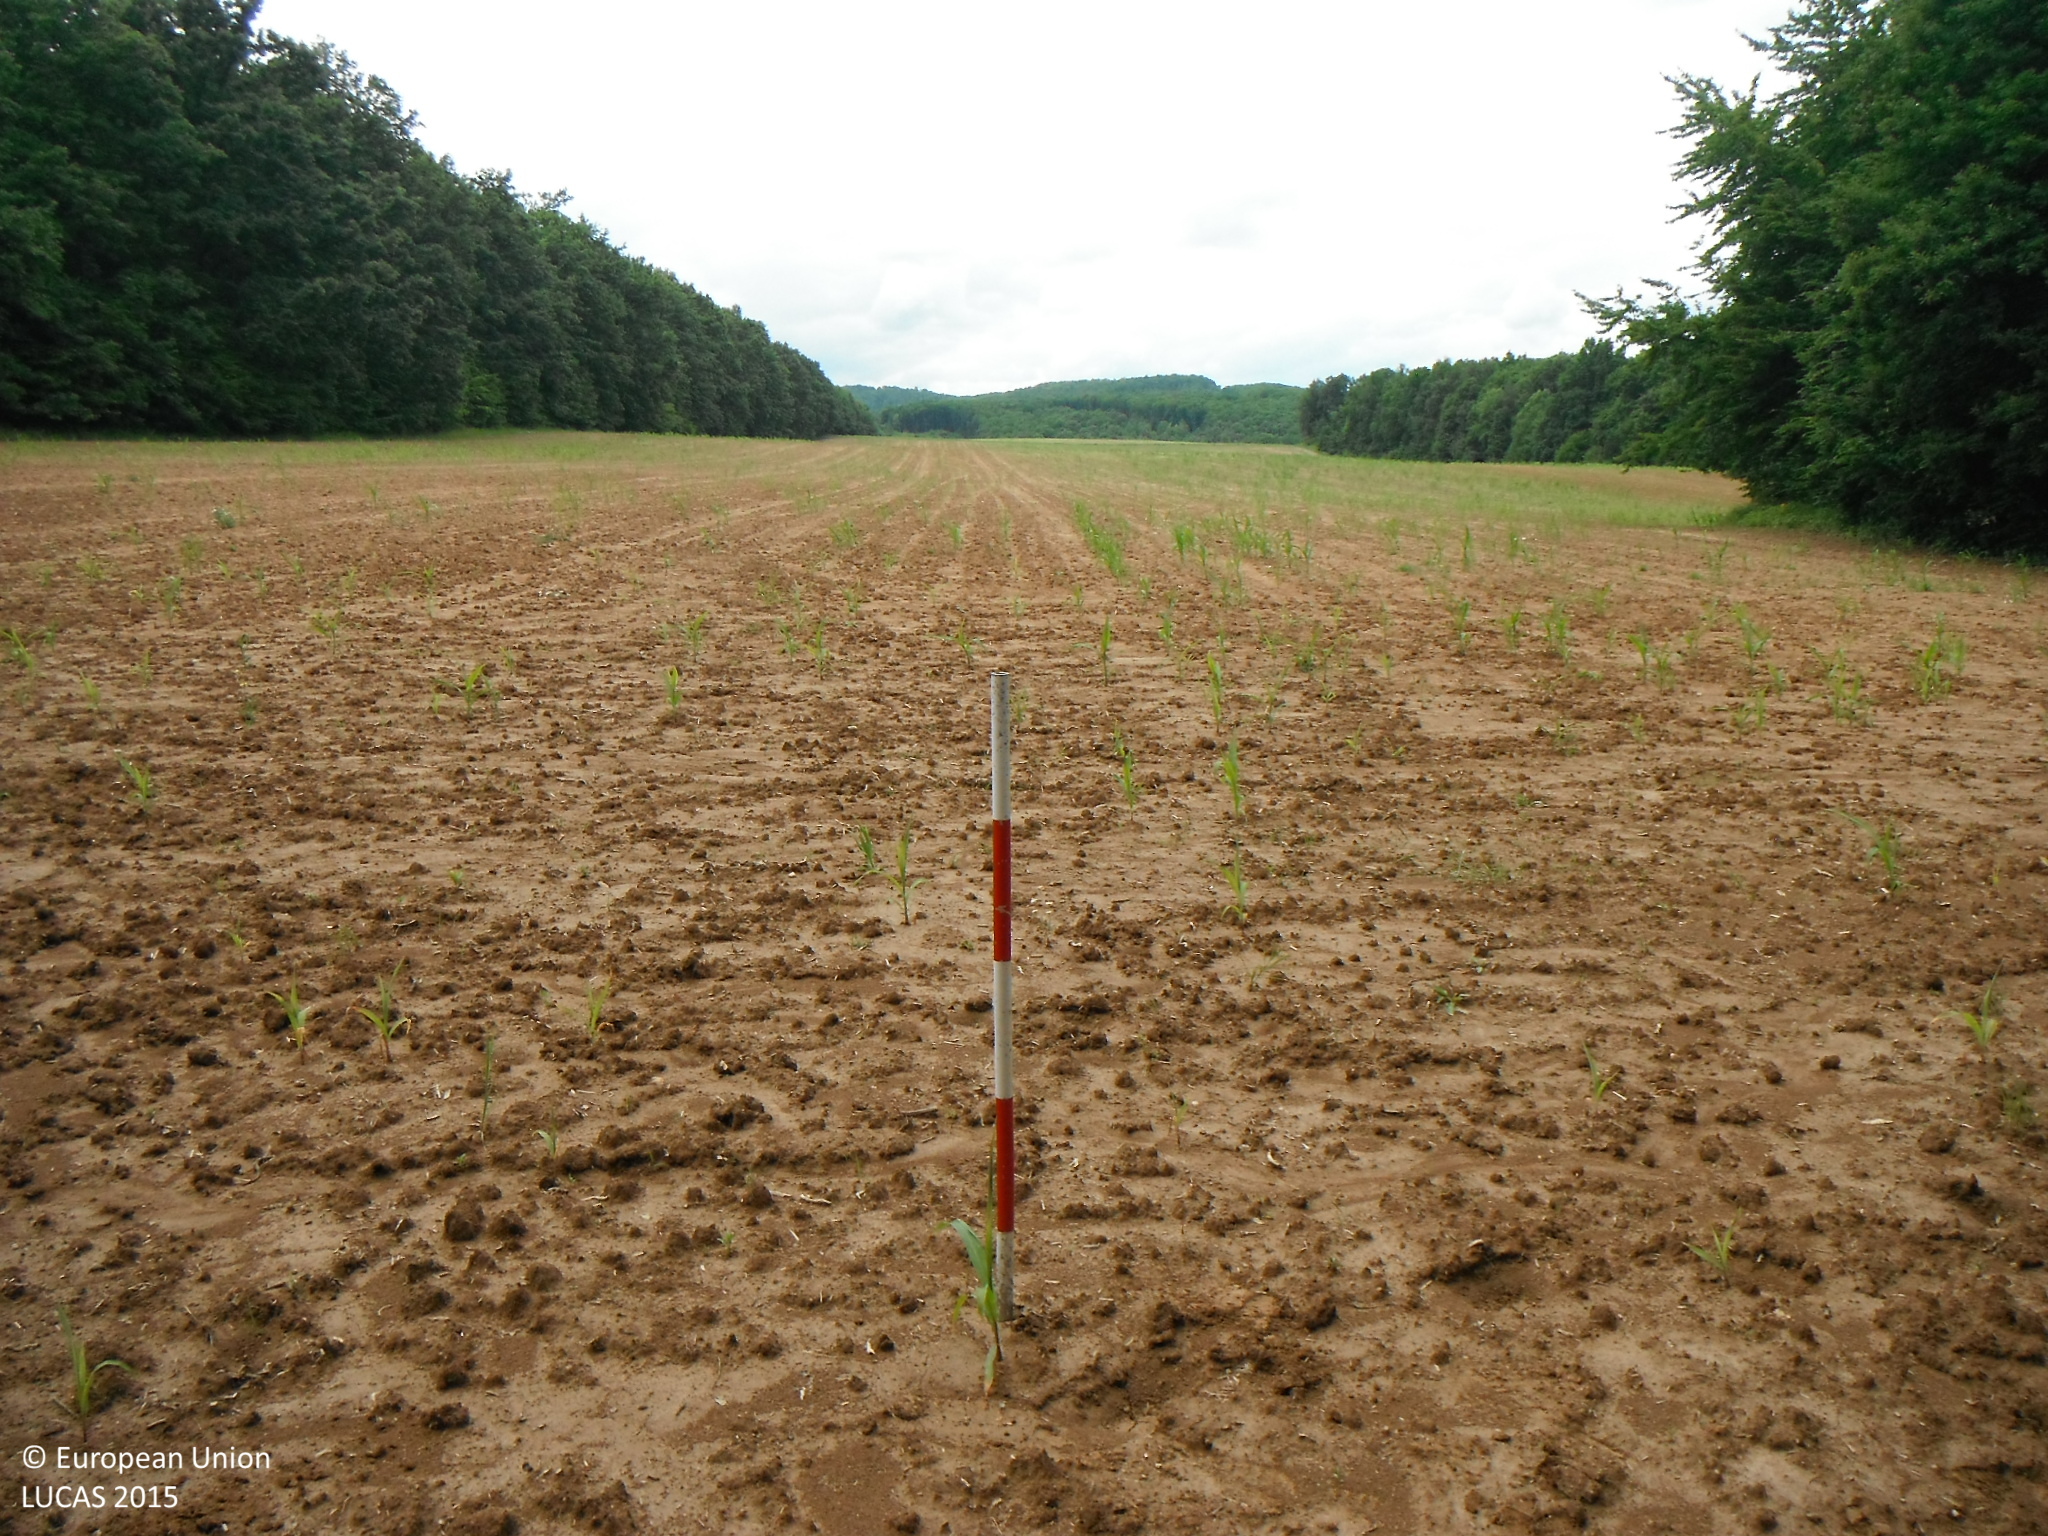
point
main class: Cropland
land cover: Maize
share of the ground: < 10 %
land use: Agriculture (excluding fallow land and kitchen gardens)
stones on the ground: < 10 %
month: June
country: SK
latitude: 48.4644
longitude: 19.9148
